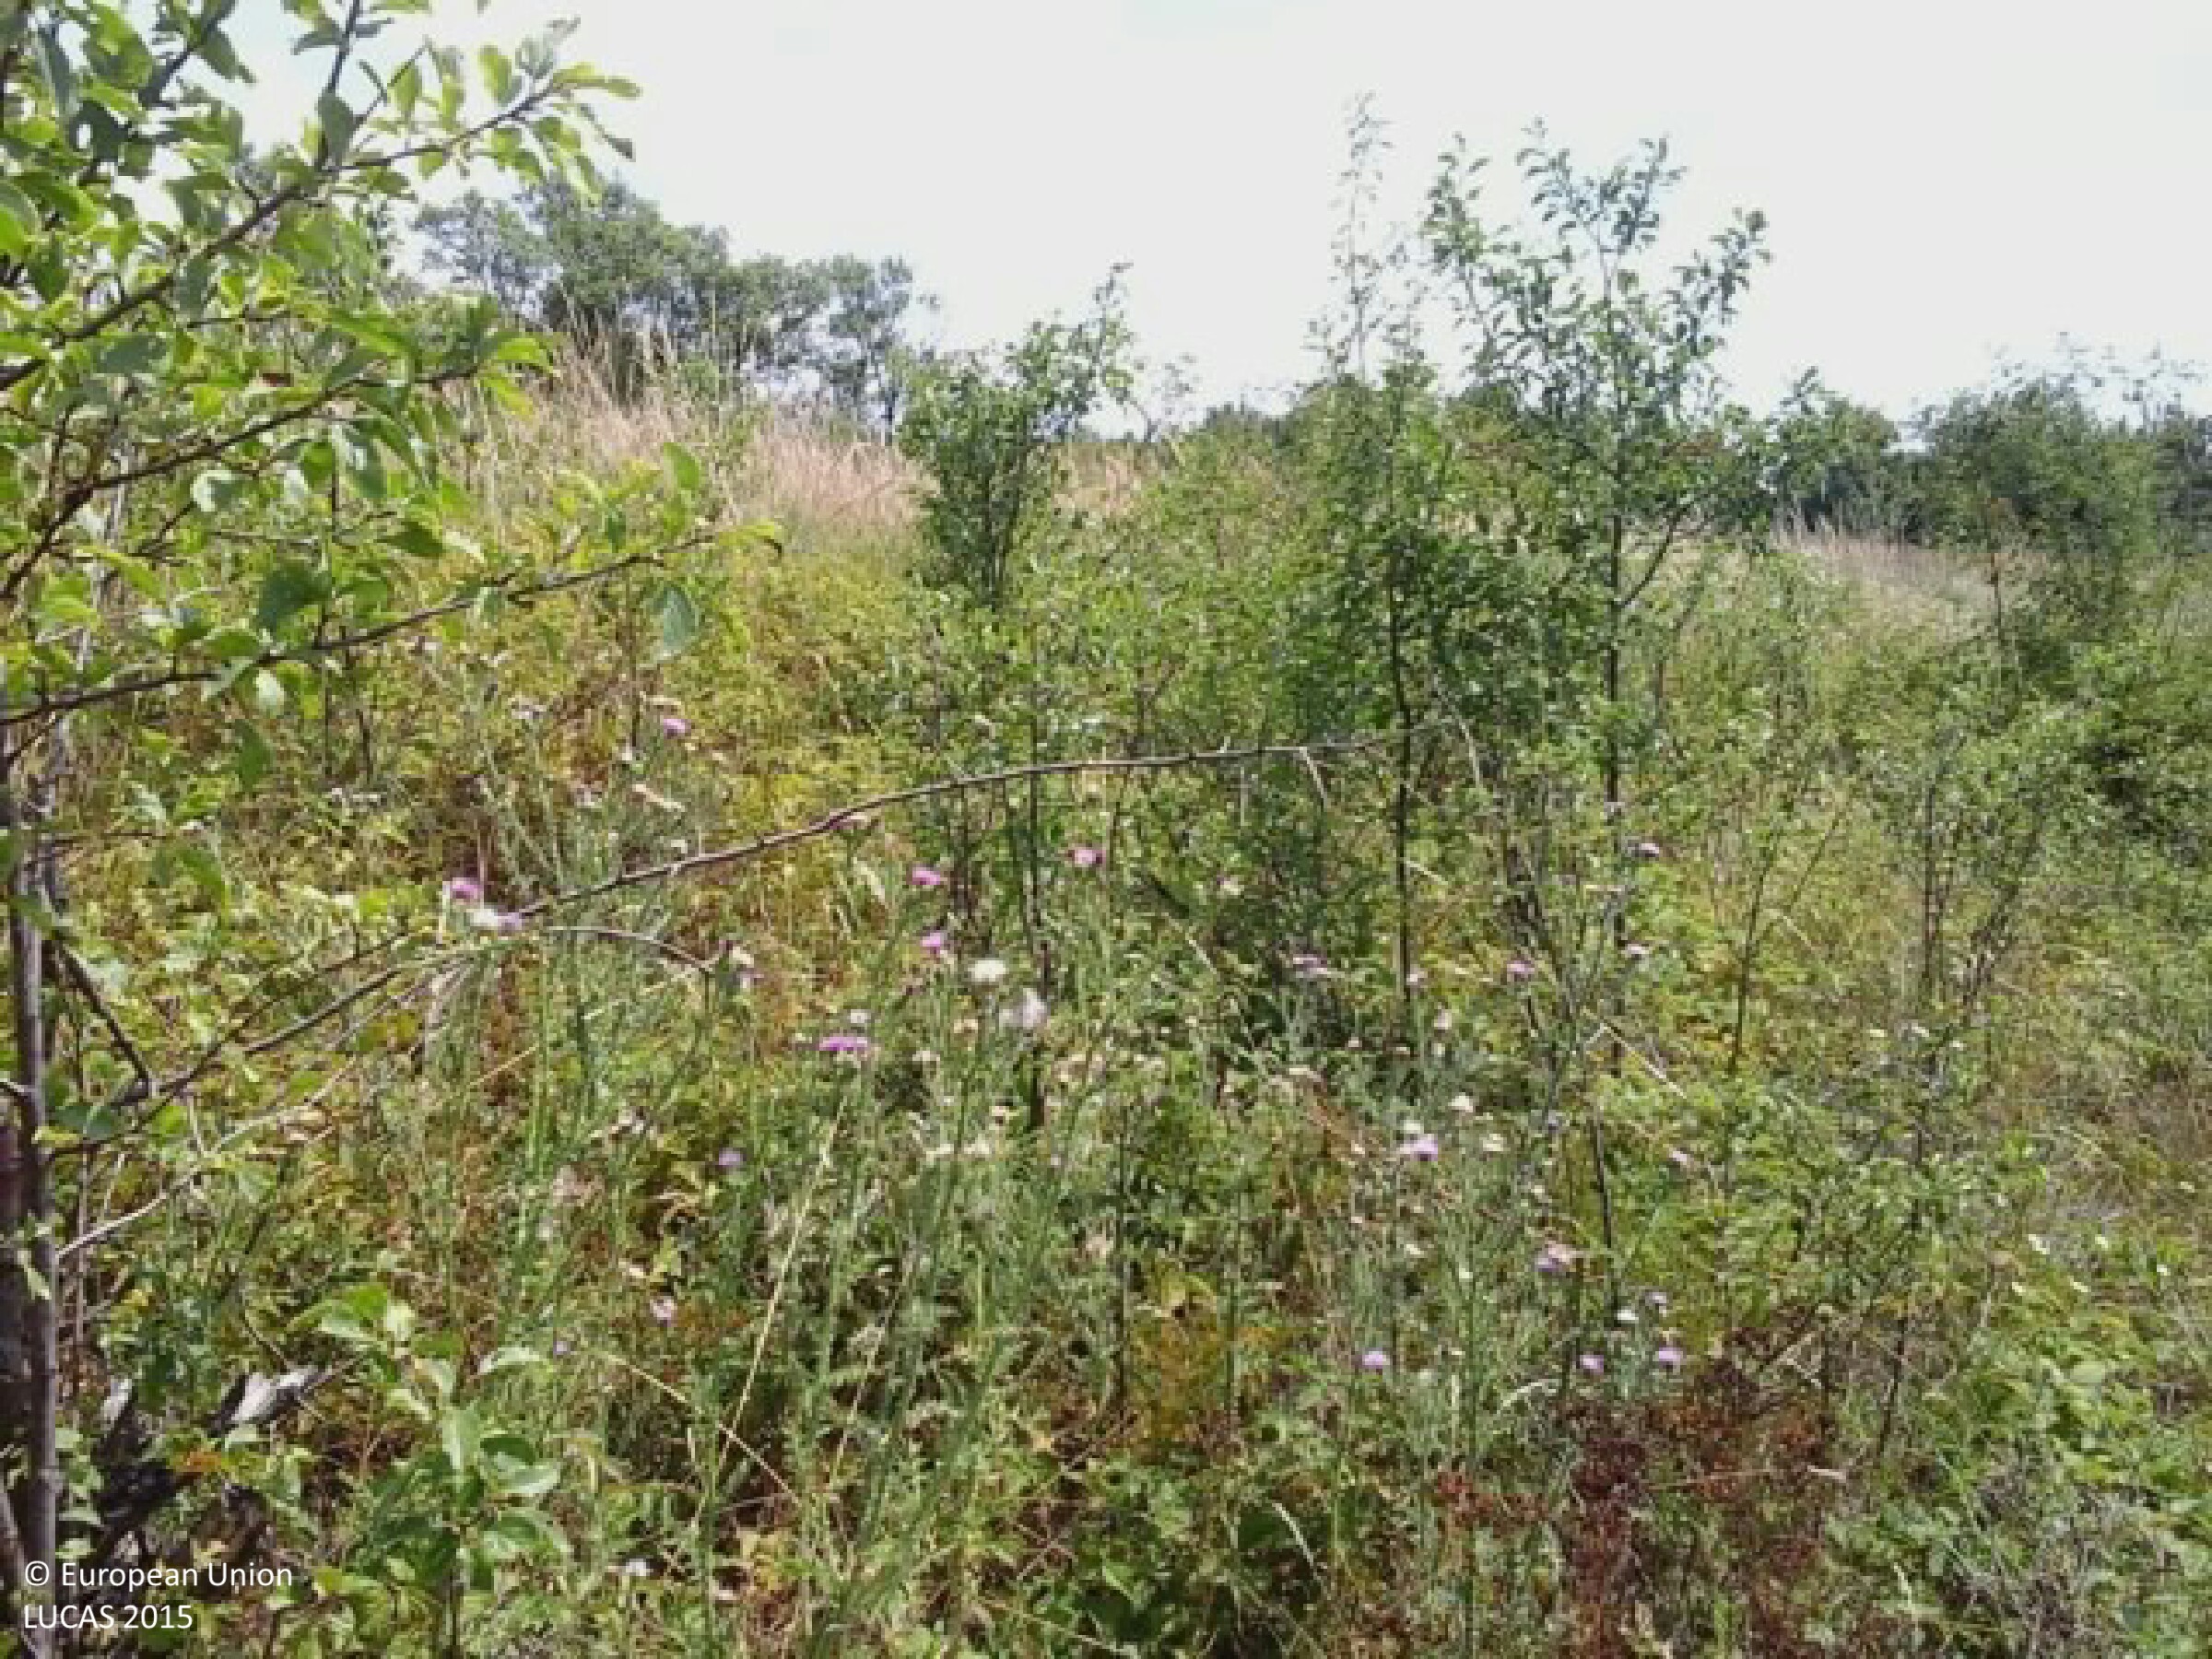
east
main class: Grassland
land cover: Grassland with sparse tree/shrub cover
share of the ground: > 75 %
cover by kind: herbaceous plants 90 %, broadleaved forest trees 5 %, shrubs 5 %
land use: Abandoned areas
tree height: < 5 m
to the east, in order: Grassland with sparse tree/shrub cover; Broadleaved woodland; Common wheat
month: July
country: HU
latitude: 48.3279
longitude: 20.7876
